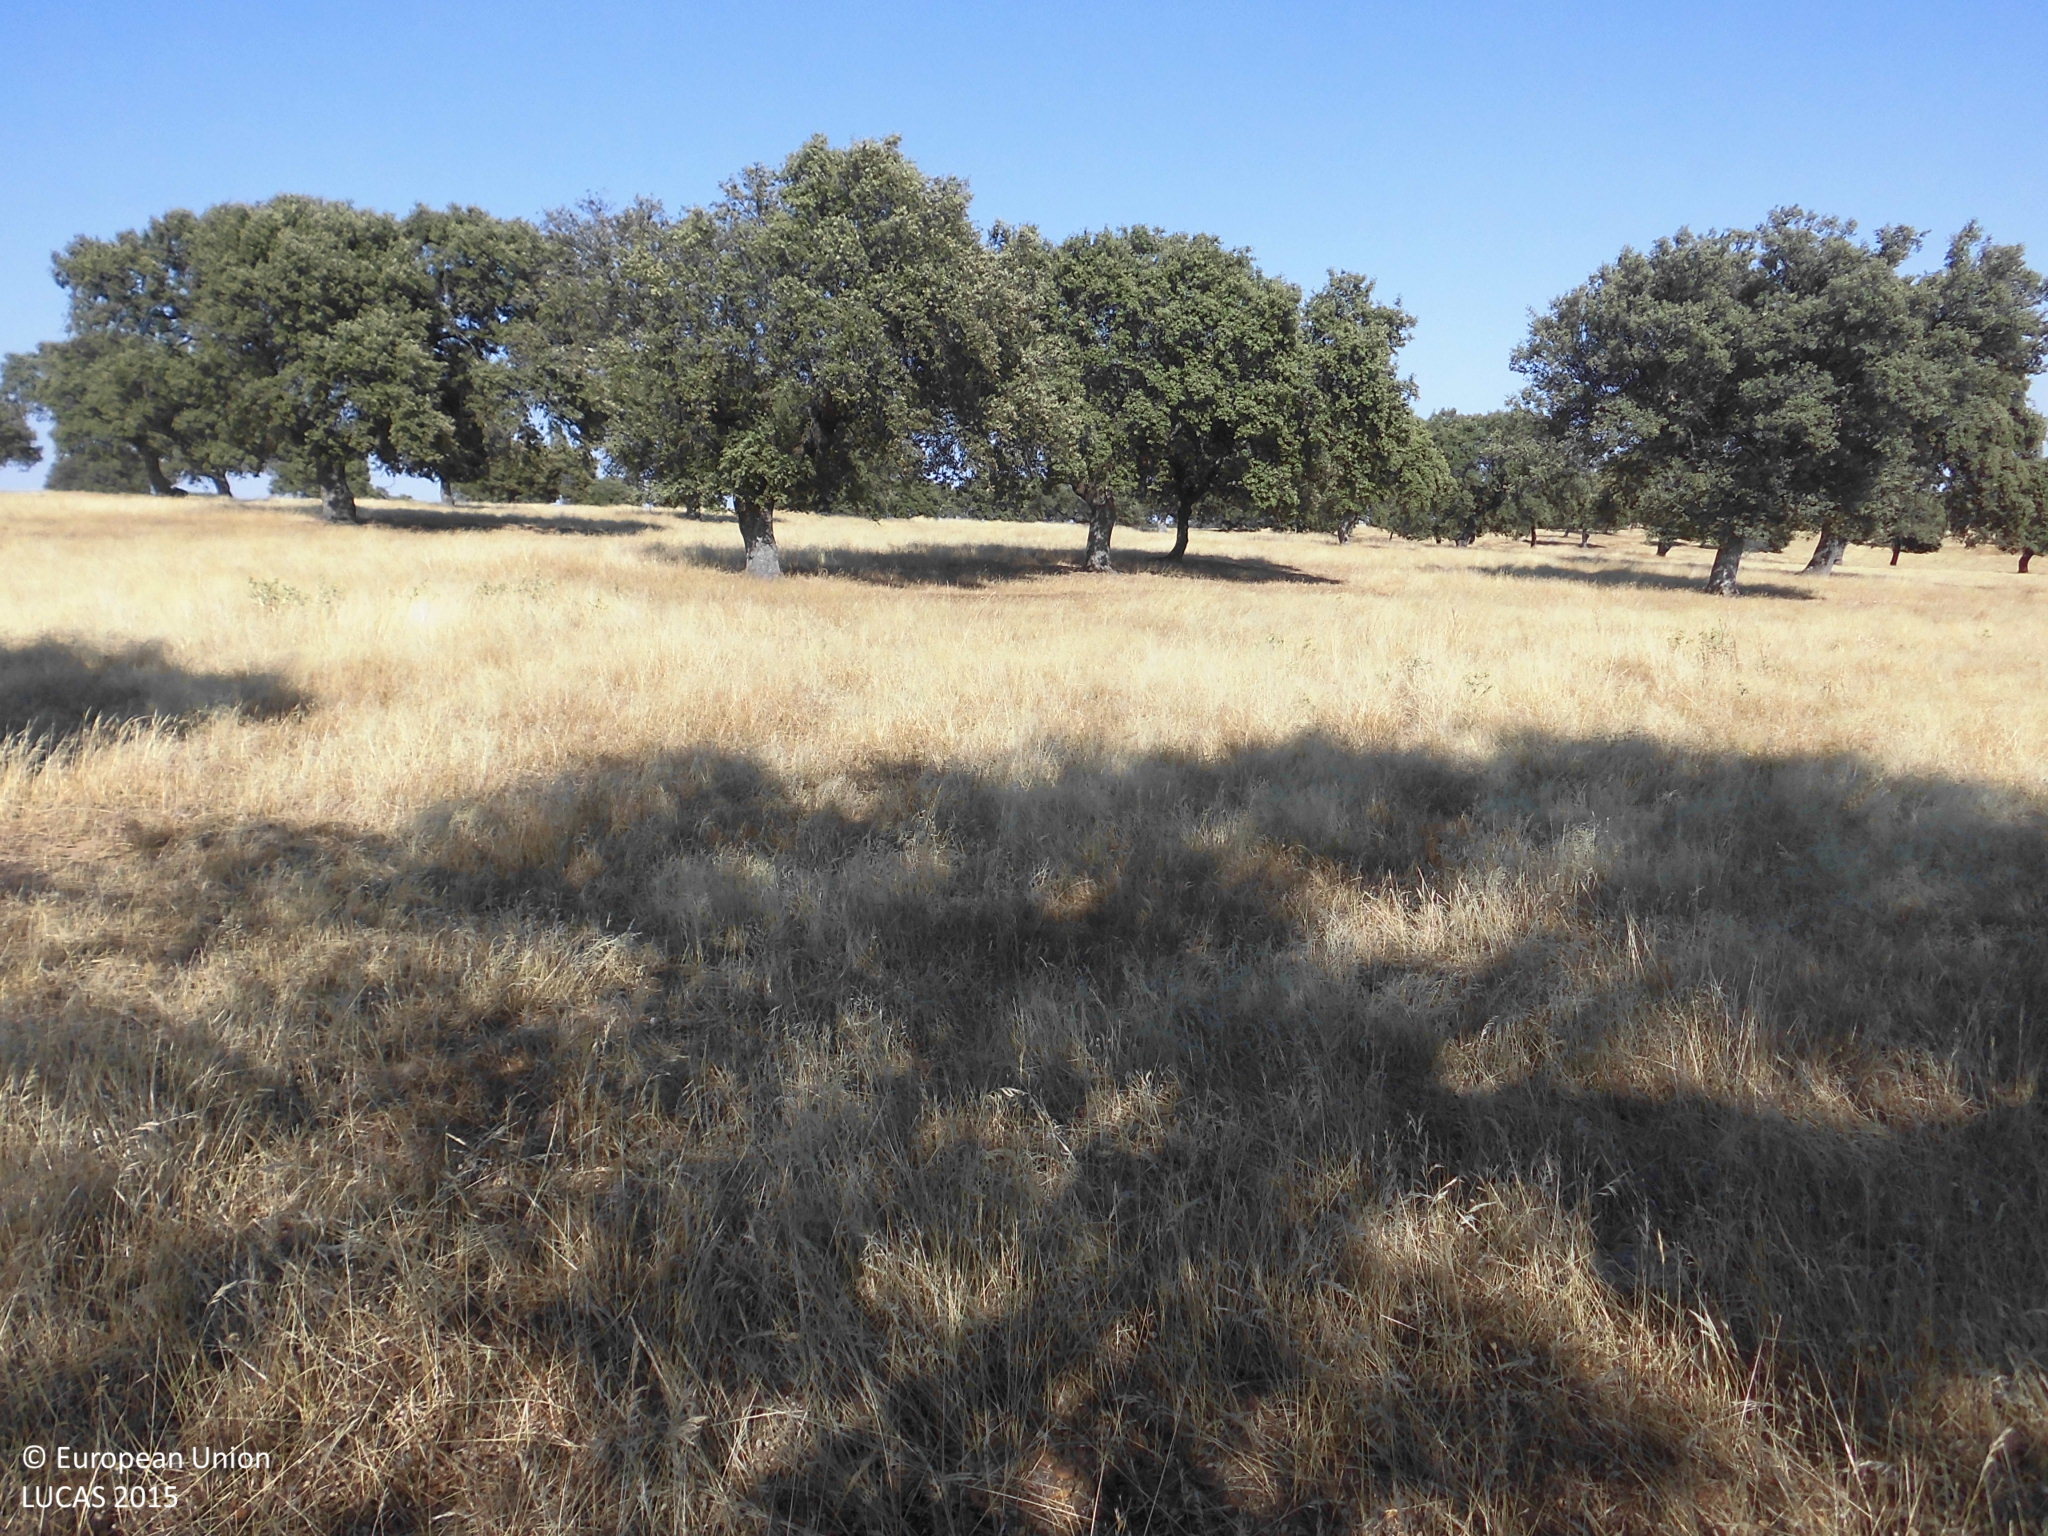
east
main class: Woodland
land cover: Broadleaved woodland
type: broadleaved evergreen forest
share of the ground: 10 - 25 %
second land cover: Grassland without tree/shrub cover
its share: > 75 %
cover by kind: herbaceous plants 85 %, broadleaved forest trees 15 %
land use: Forestry
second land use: Agriculture (excluding fallow land and kitchen gardens)
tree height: > 5 m
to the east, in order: Broadleaved woodland; Grassland without tree/shrub cover; Broadleaved woodland
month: June
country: ES
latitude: 39.6451
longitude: -5.9932
